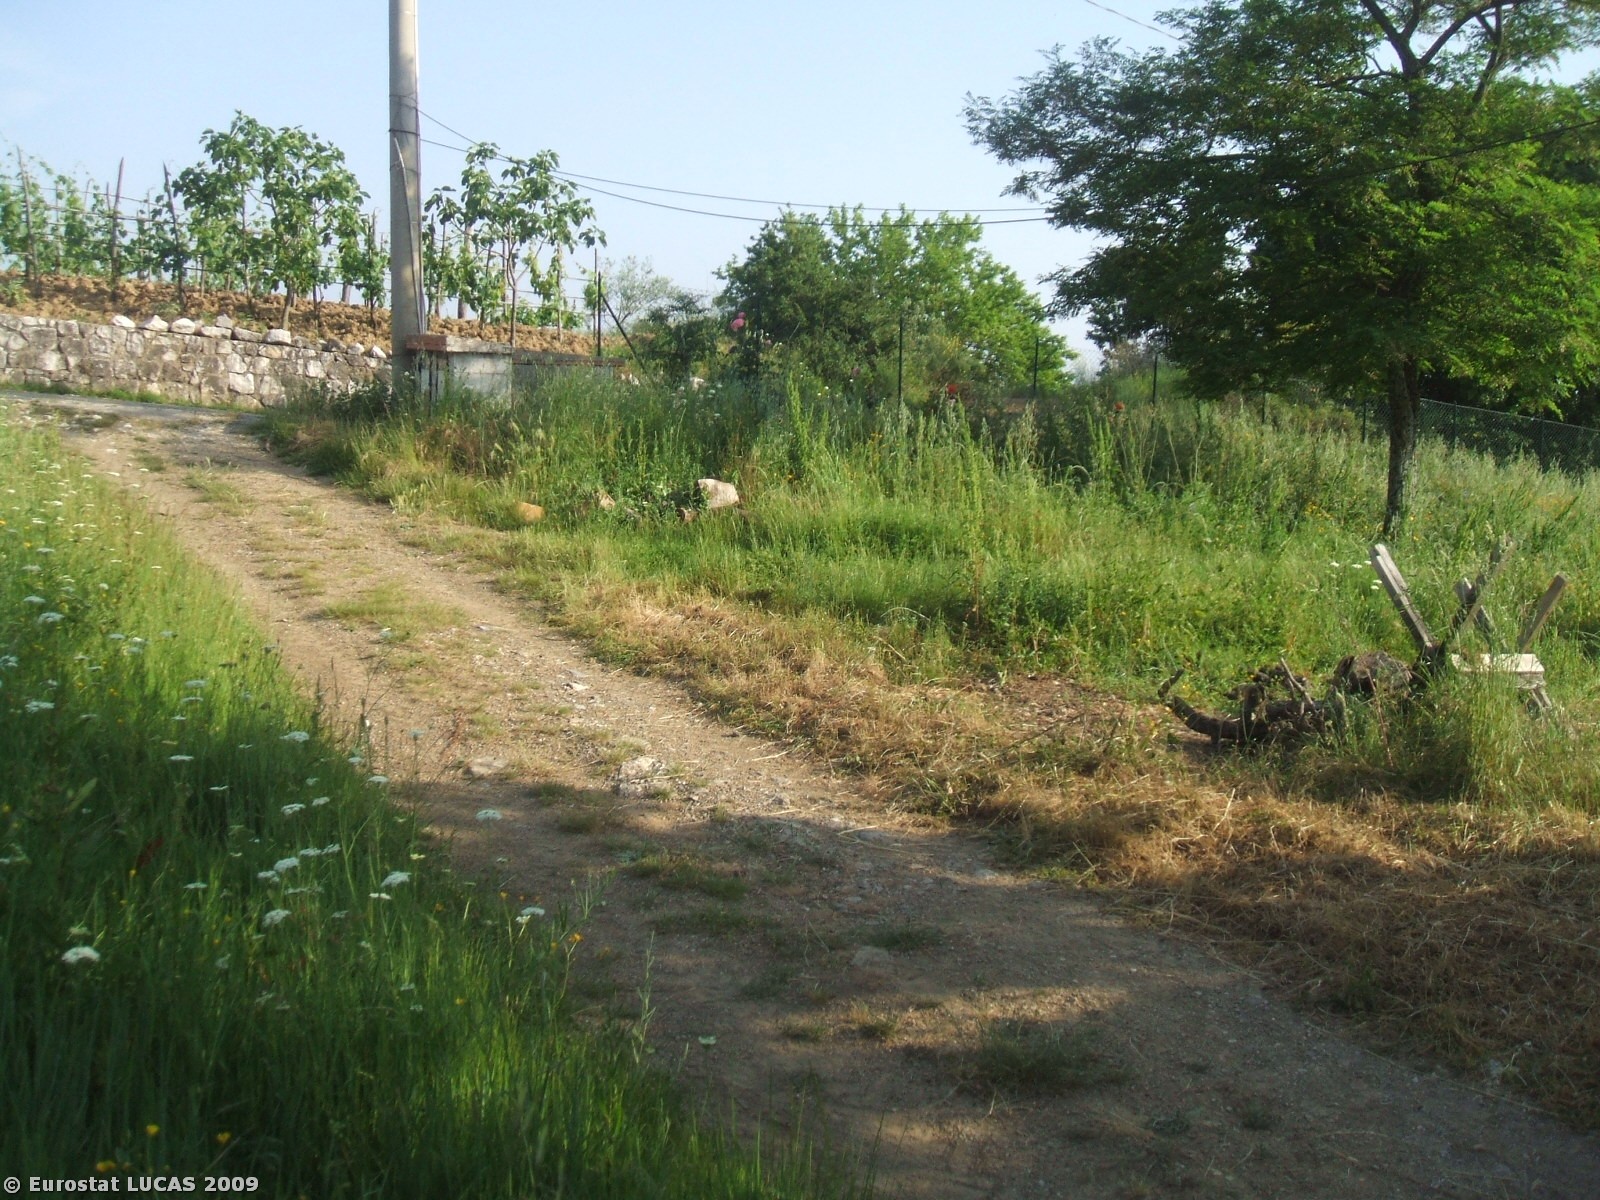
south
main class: Grassland
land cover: Spontaneously vegetated surfaces
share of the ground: > 75 %
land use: Fallow land
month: May
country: IT
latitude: 40.1838
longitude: 15.5312
